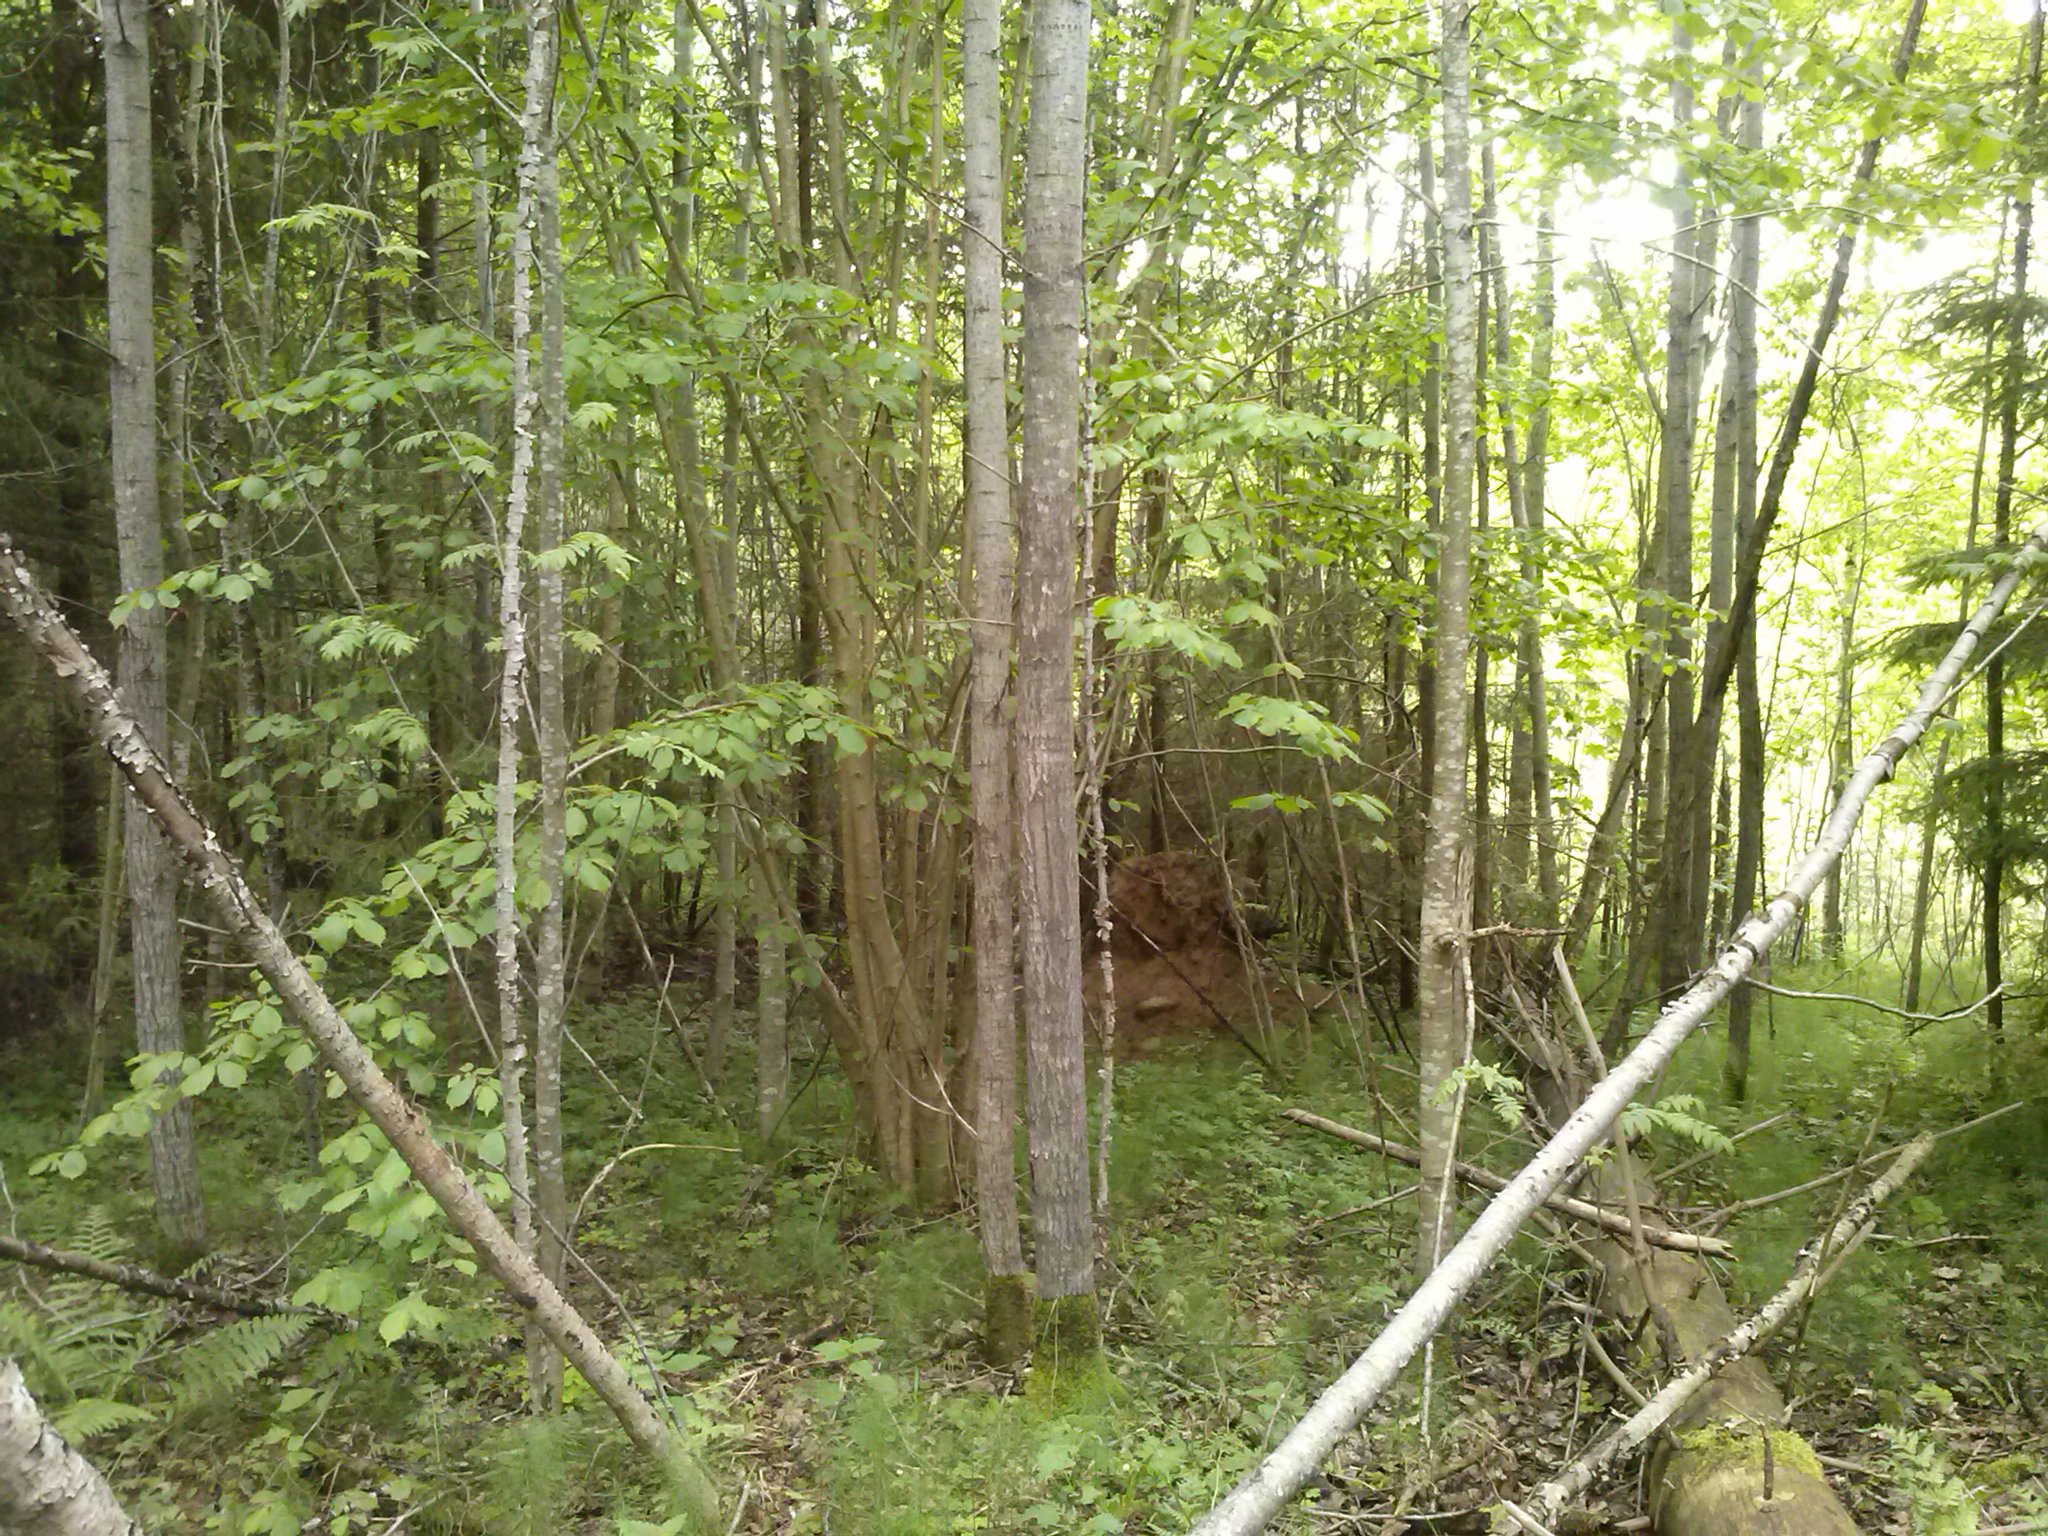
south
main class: Woodland
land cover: Broadleaved woodland
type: non-riverine alder, birch or aspen forest
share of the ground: > 75 %
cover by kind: broadleaved forest trees 80 %, coniferous forest trees 10 %, herbaceous plants 10 %
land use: Forestry
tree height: > 5 m
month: May
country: LV
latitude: 56.2270
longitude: 27.7542
